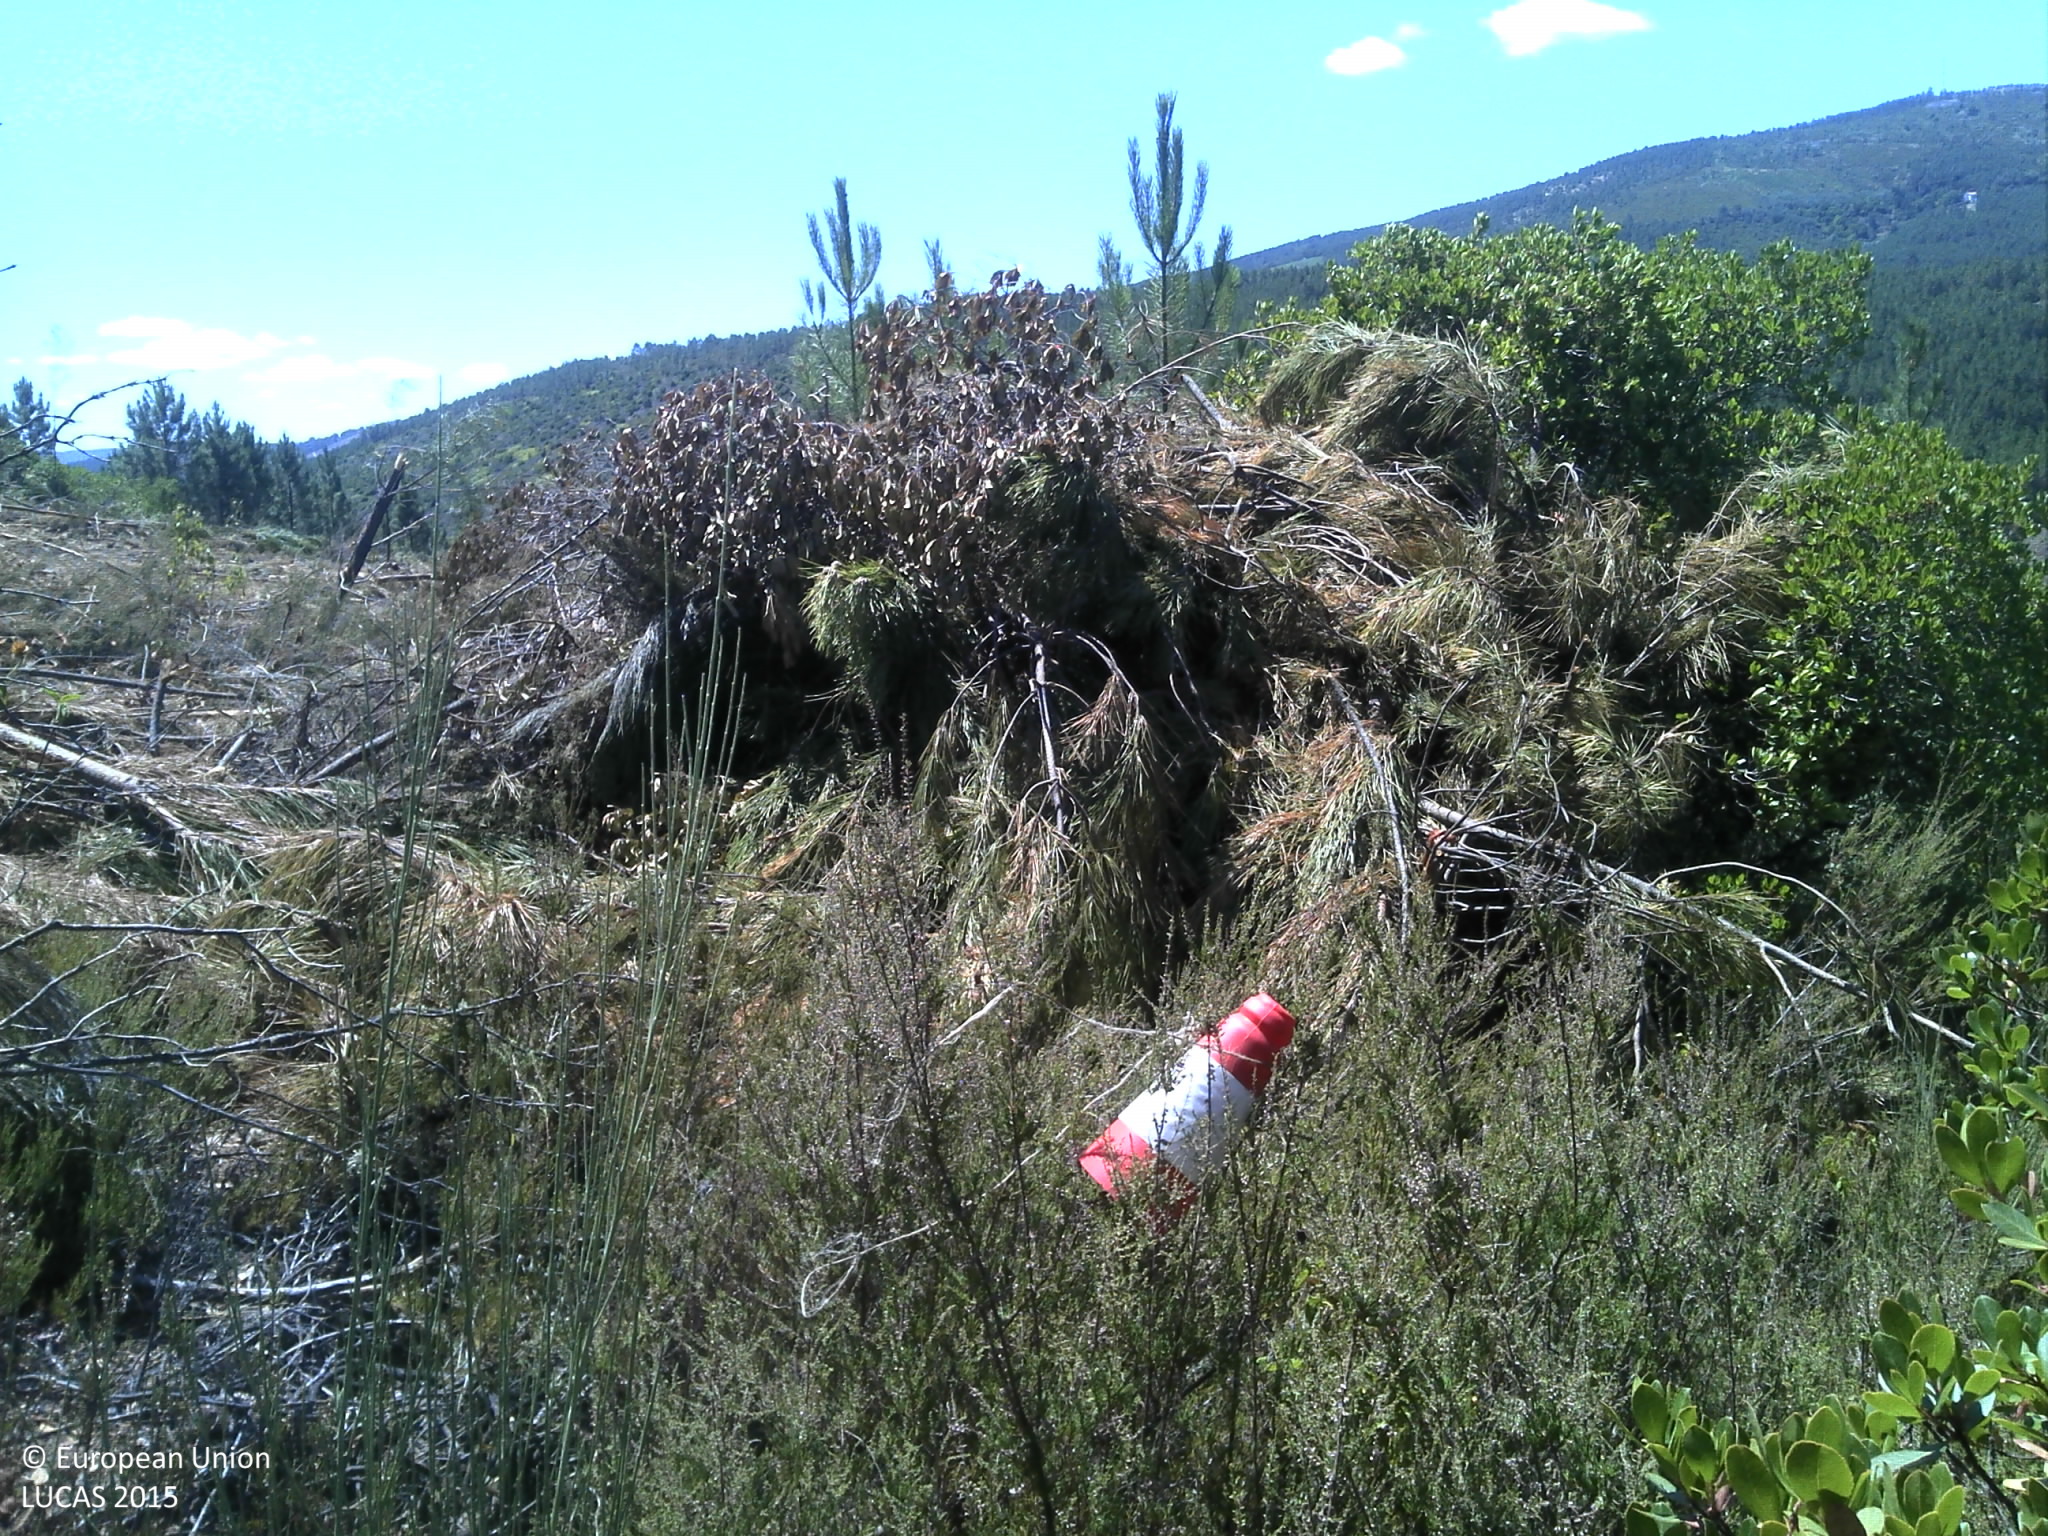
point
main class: Shrubland
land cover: Shrubland without tree cover
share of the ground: 50 - 75 %
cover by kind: shrubs 70 %, herbaceous plants 10 %, unconsolidated bare surface 10 %
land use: Forestry
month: July
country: PT
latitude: 40.1870
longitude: -7.7415
